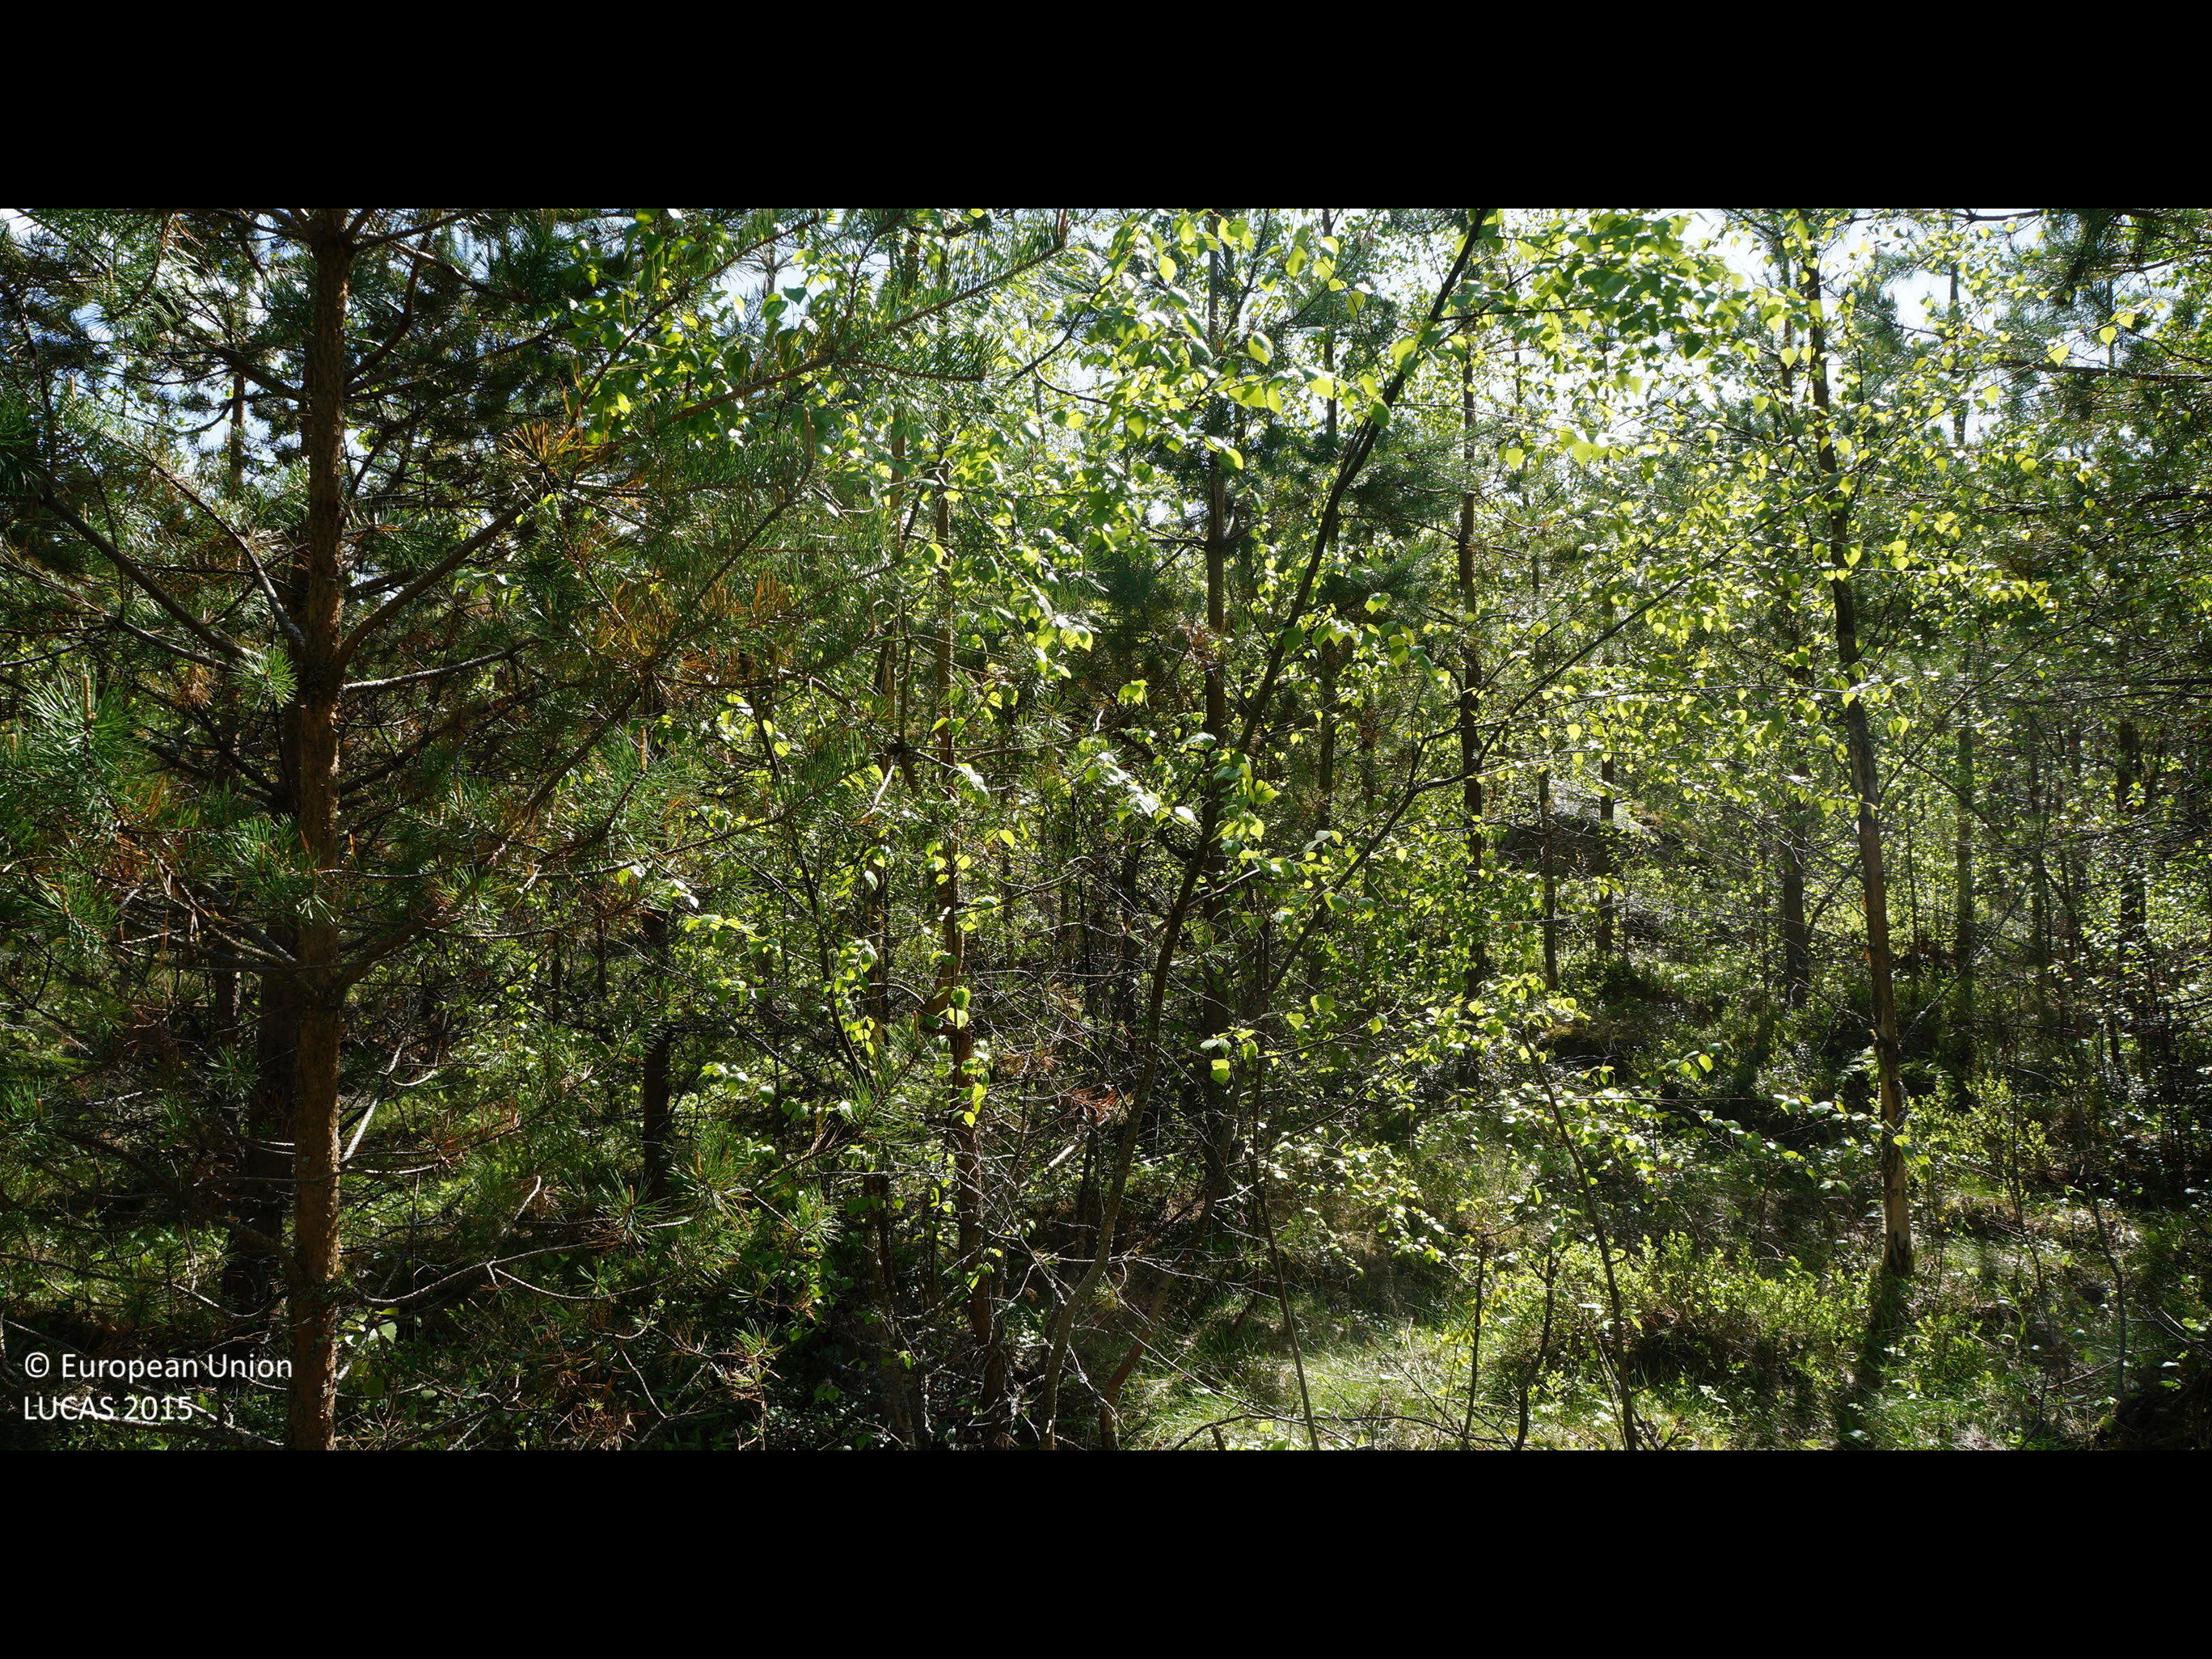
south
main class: Woodland
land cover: Other mixed woodland
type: boreal forest
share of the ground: > 75 %
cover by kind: coniferous forest trees 60 %, broadleaved forest trees 20 %, shrubs 20 %
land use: Forestry
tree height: > 5 m
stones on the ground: > 50 %
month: June
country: FI
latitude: 63.7413
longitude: 23.3264
